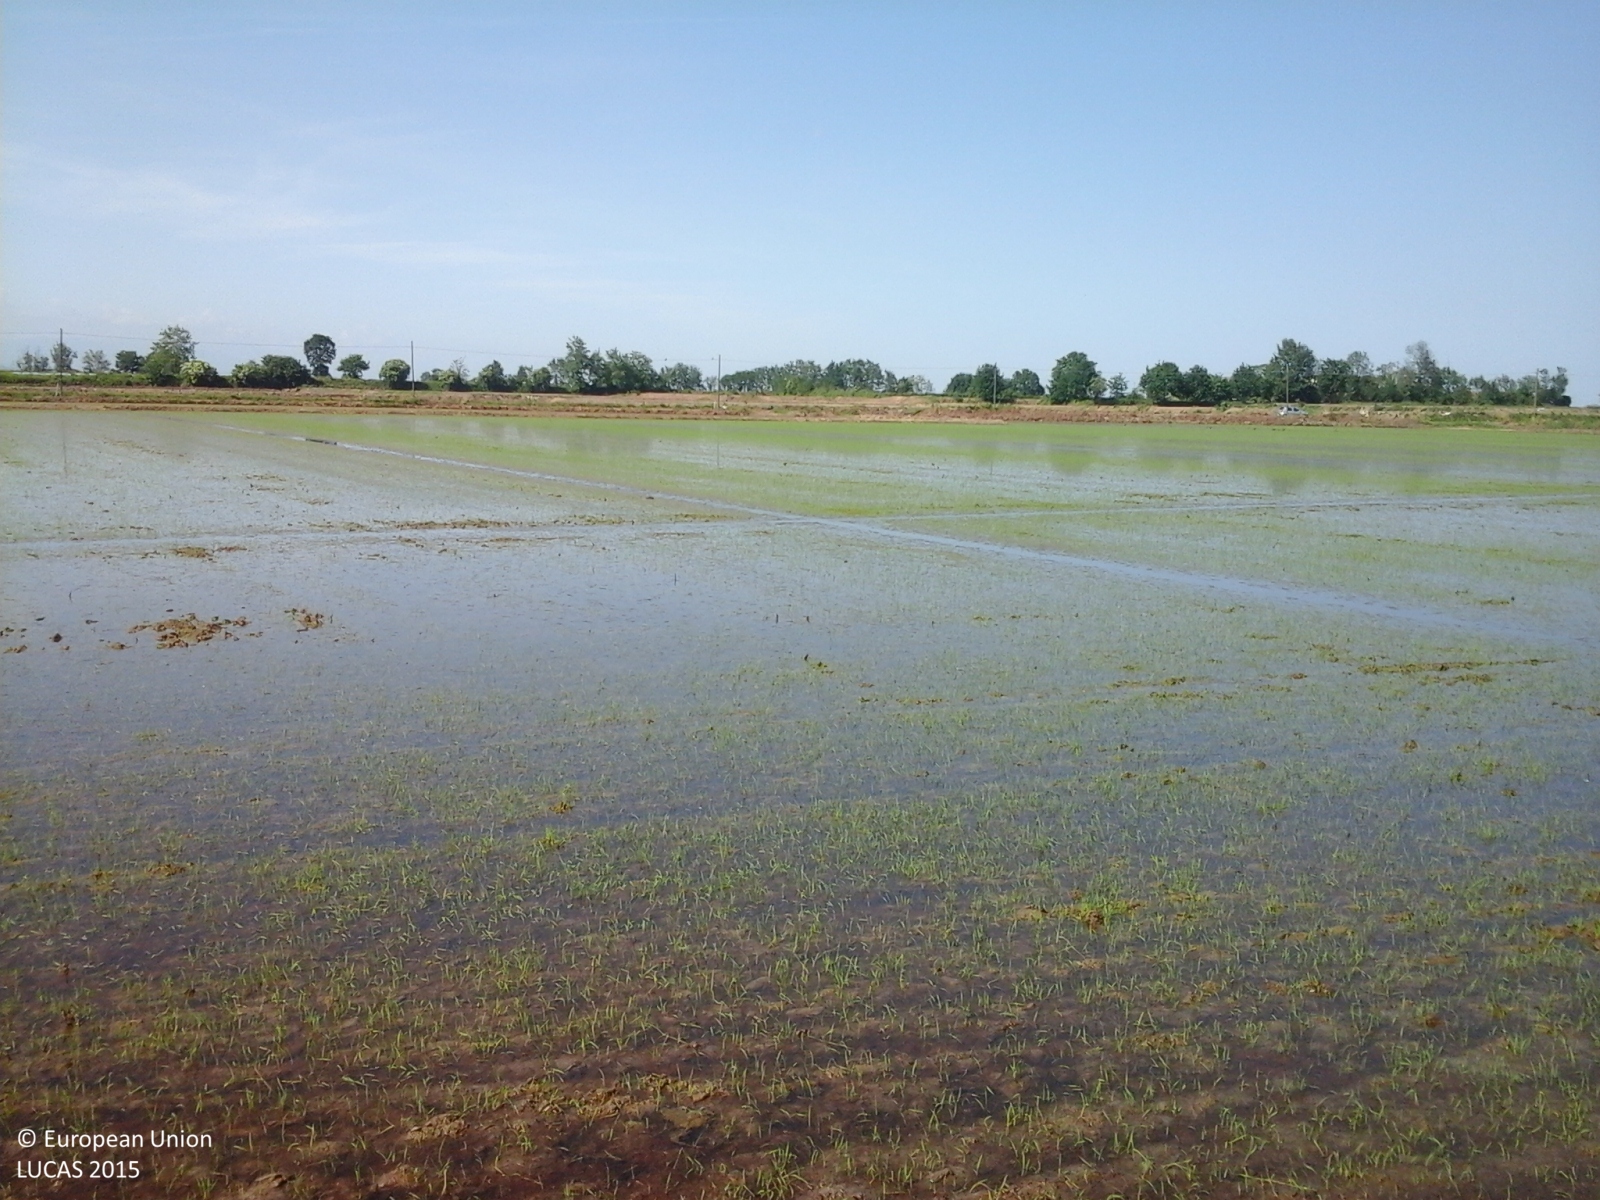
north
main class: Cropland
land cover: Rice
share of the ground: > 75 %
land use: Agriculture (excluding fallow land and kitchen gardens)
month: May
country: IT
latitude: 45.2170
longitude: 8.1059
